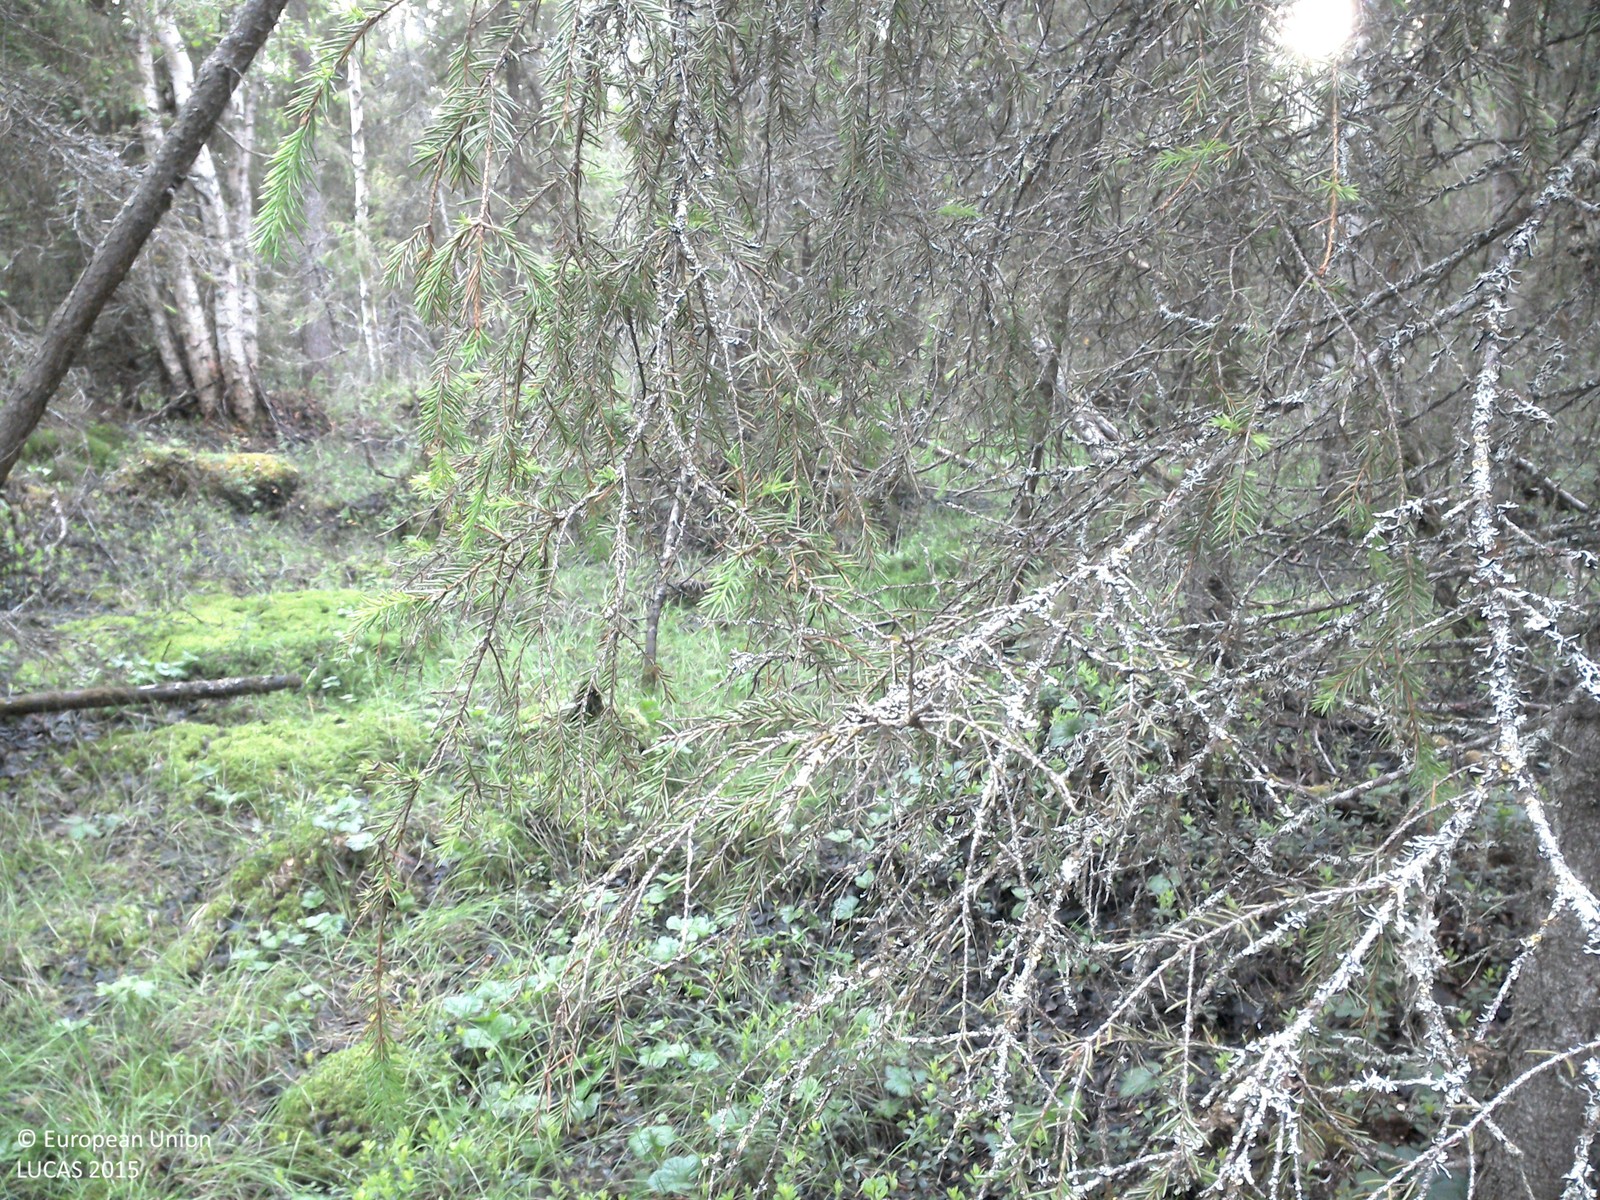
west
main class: Woodland
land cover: Spruce dominated mixed woodland
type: boreal forest
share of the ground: 25 - 50 %
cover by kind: shrubs 35 %, coniferous forest trees 25 %, broadleaved forest trees 15 %, herbaceous plants 15 %, lichens and mosses 10 %
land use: Forestry
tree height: > 5 m
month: July
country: SE
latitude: 66.8482
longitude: 23.8186
